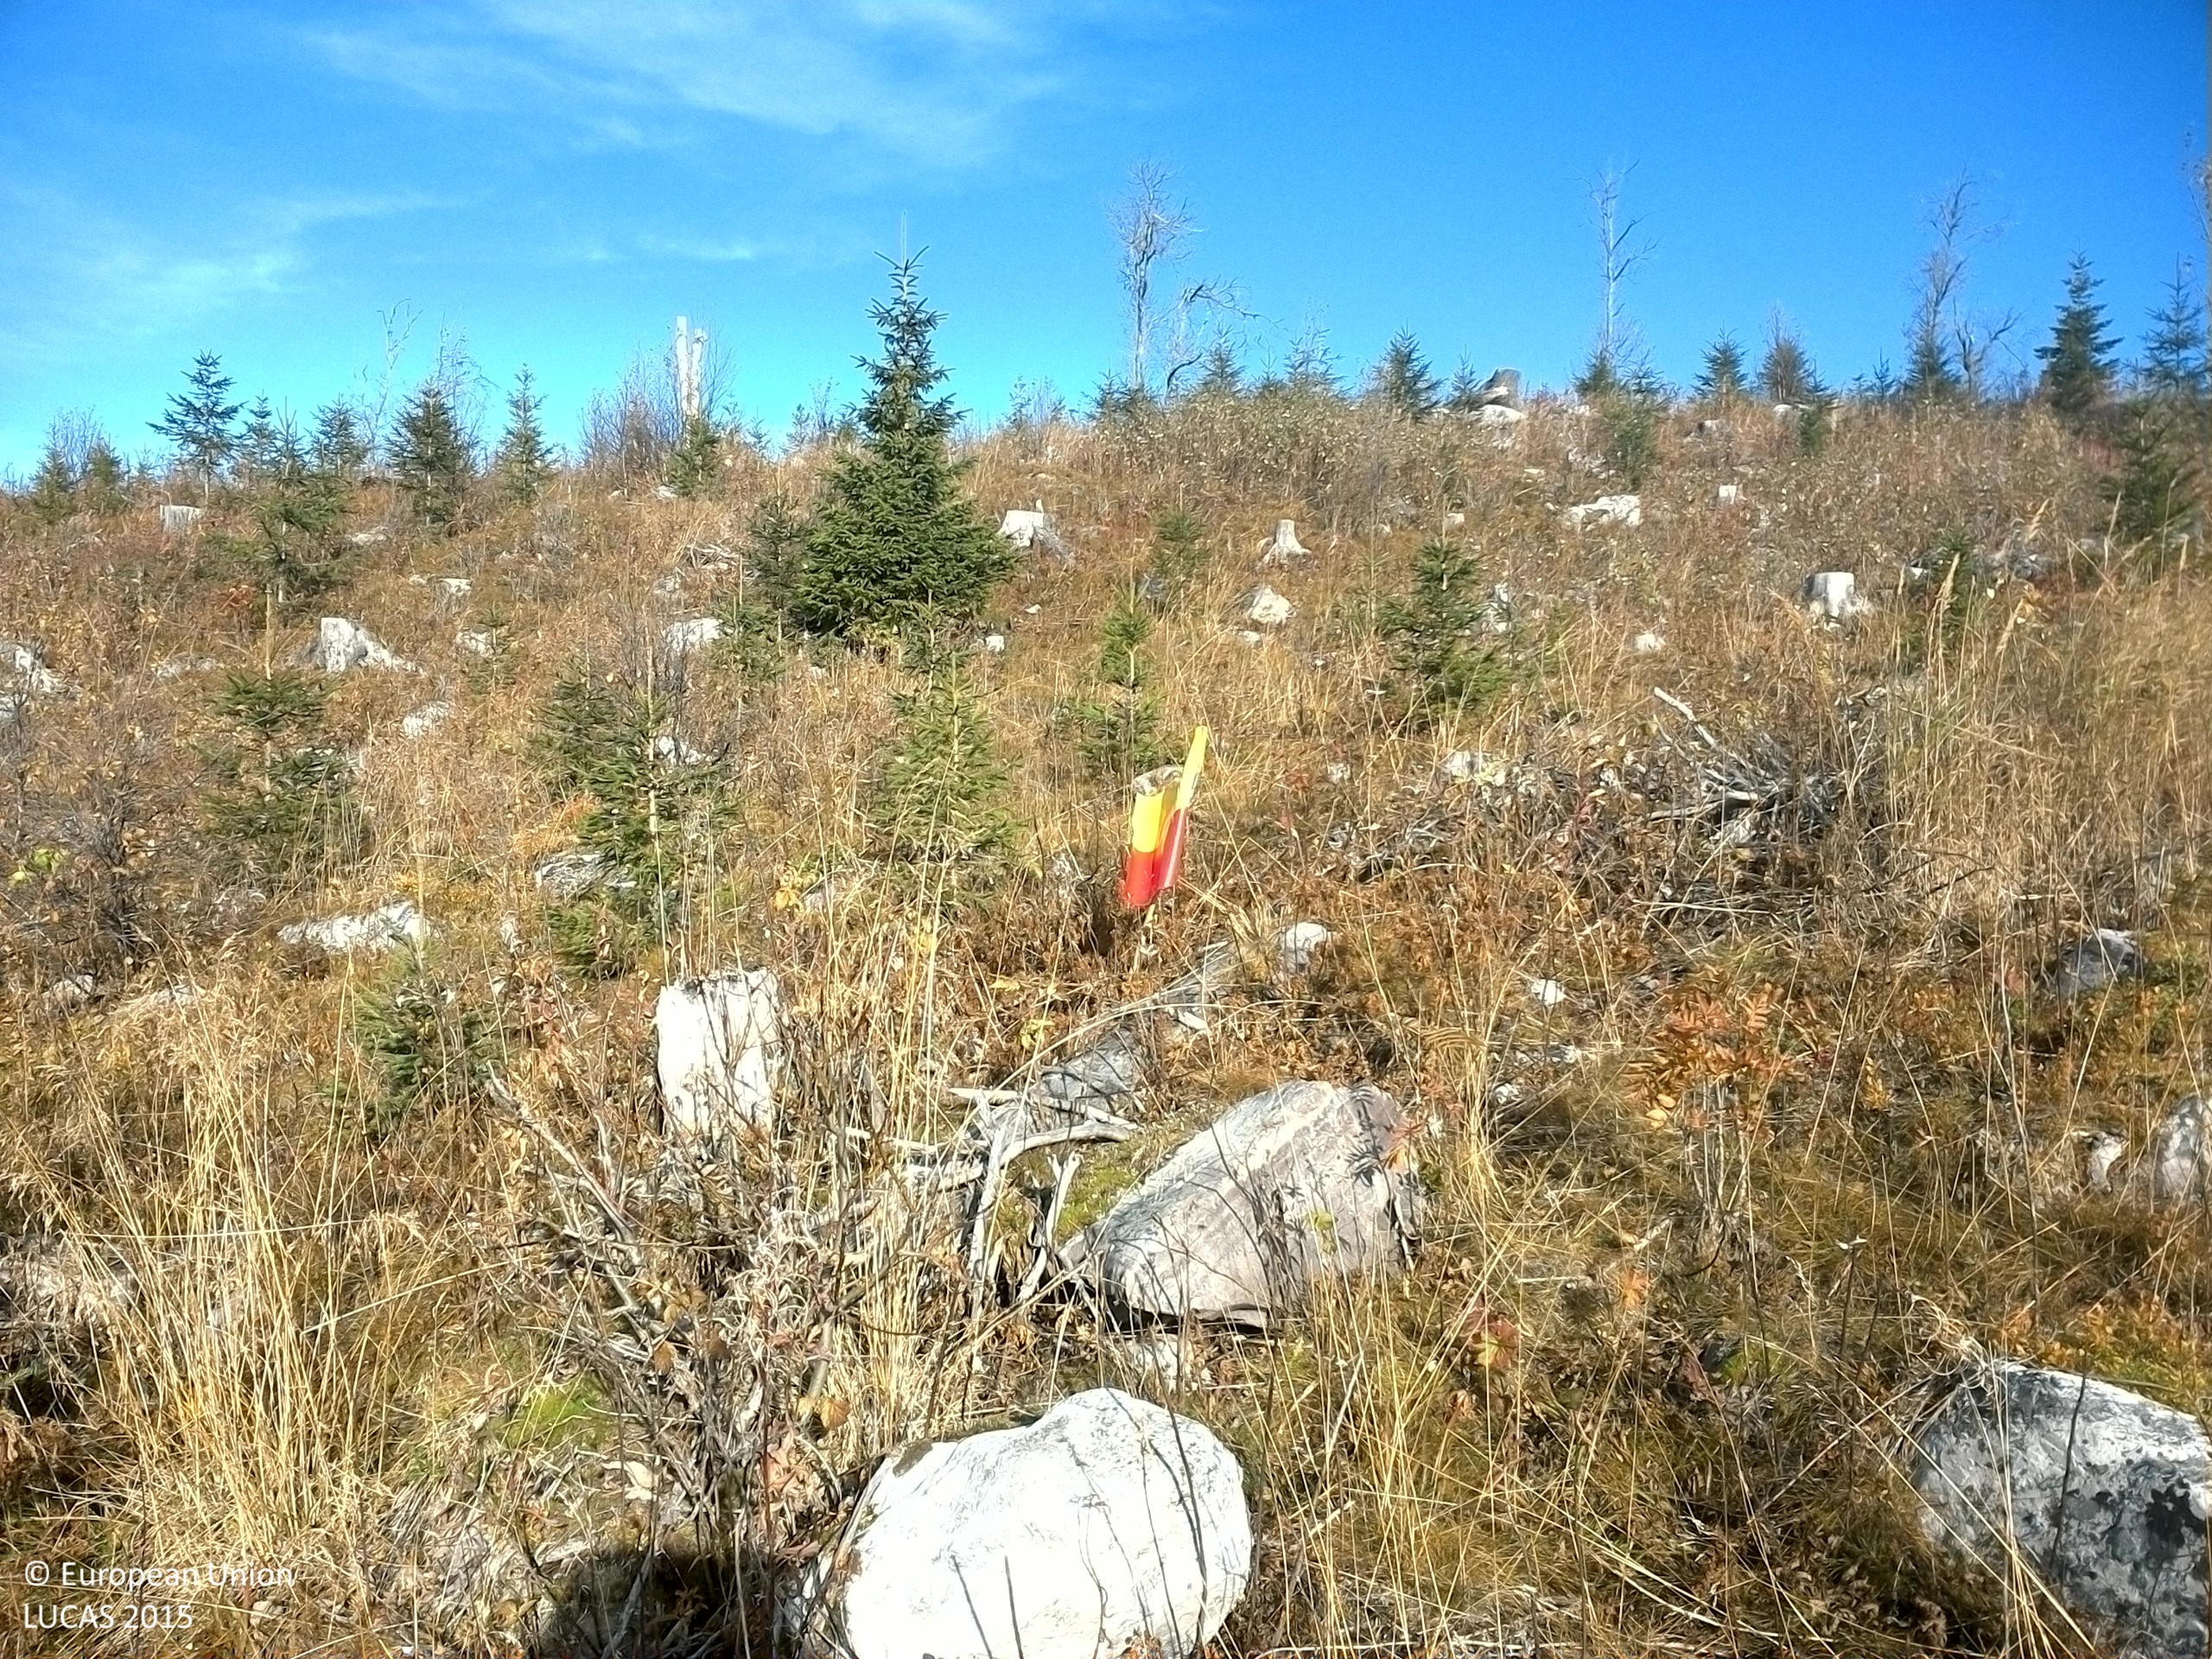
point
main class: Woodland
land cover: Spruce dominated mixed woodland
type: boreal forest
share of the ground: 10 - 25 %
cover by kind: herbaceous plants 45 %, shrubs 20 %, lichens and mosses 20 %, coniferous forest trees 10 %, broadleaved forest trees 5 %
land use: Forestry
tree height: < 5 m
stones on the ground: > 50 %
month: October
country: SE
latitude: 64.5218
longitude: 15.4498
